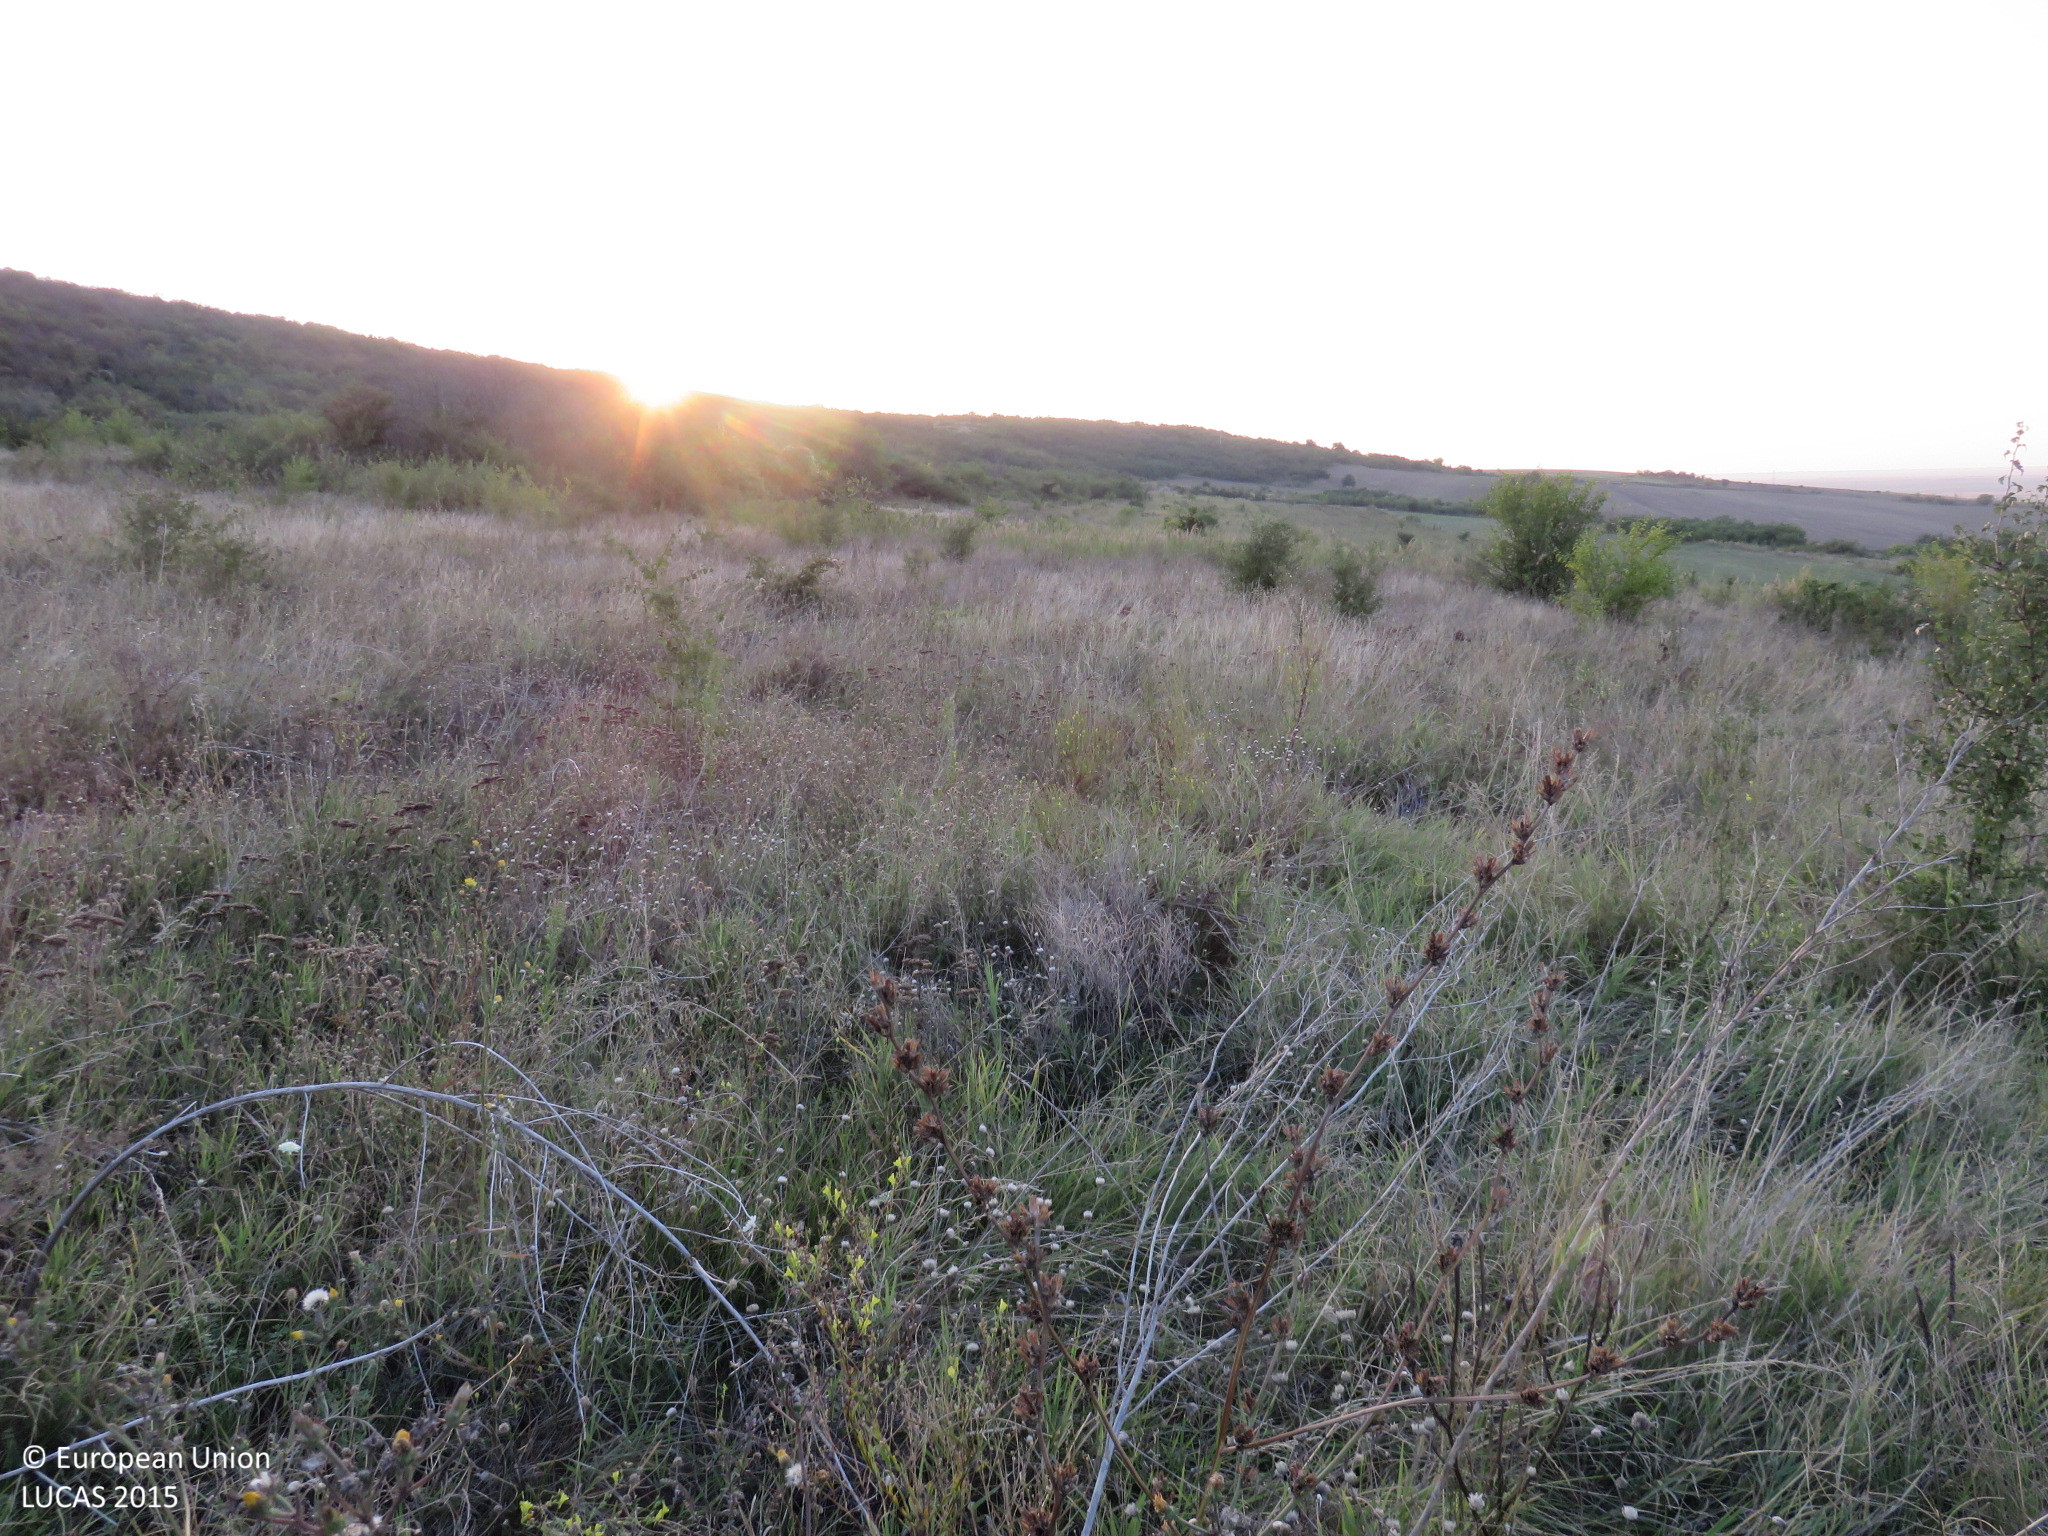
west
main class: Grassland
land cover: Grassland with sparse tree/shrub cover
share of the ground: > 75 %
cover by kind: herbaceous plants 85 %, shrubs 10 %, broadleaved forest trees 5 %
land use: Fallow land
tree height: < 5 m
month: September
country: BG
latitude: 43.6752
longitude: 24.4883
